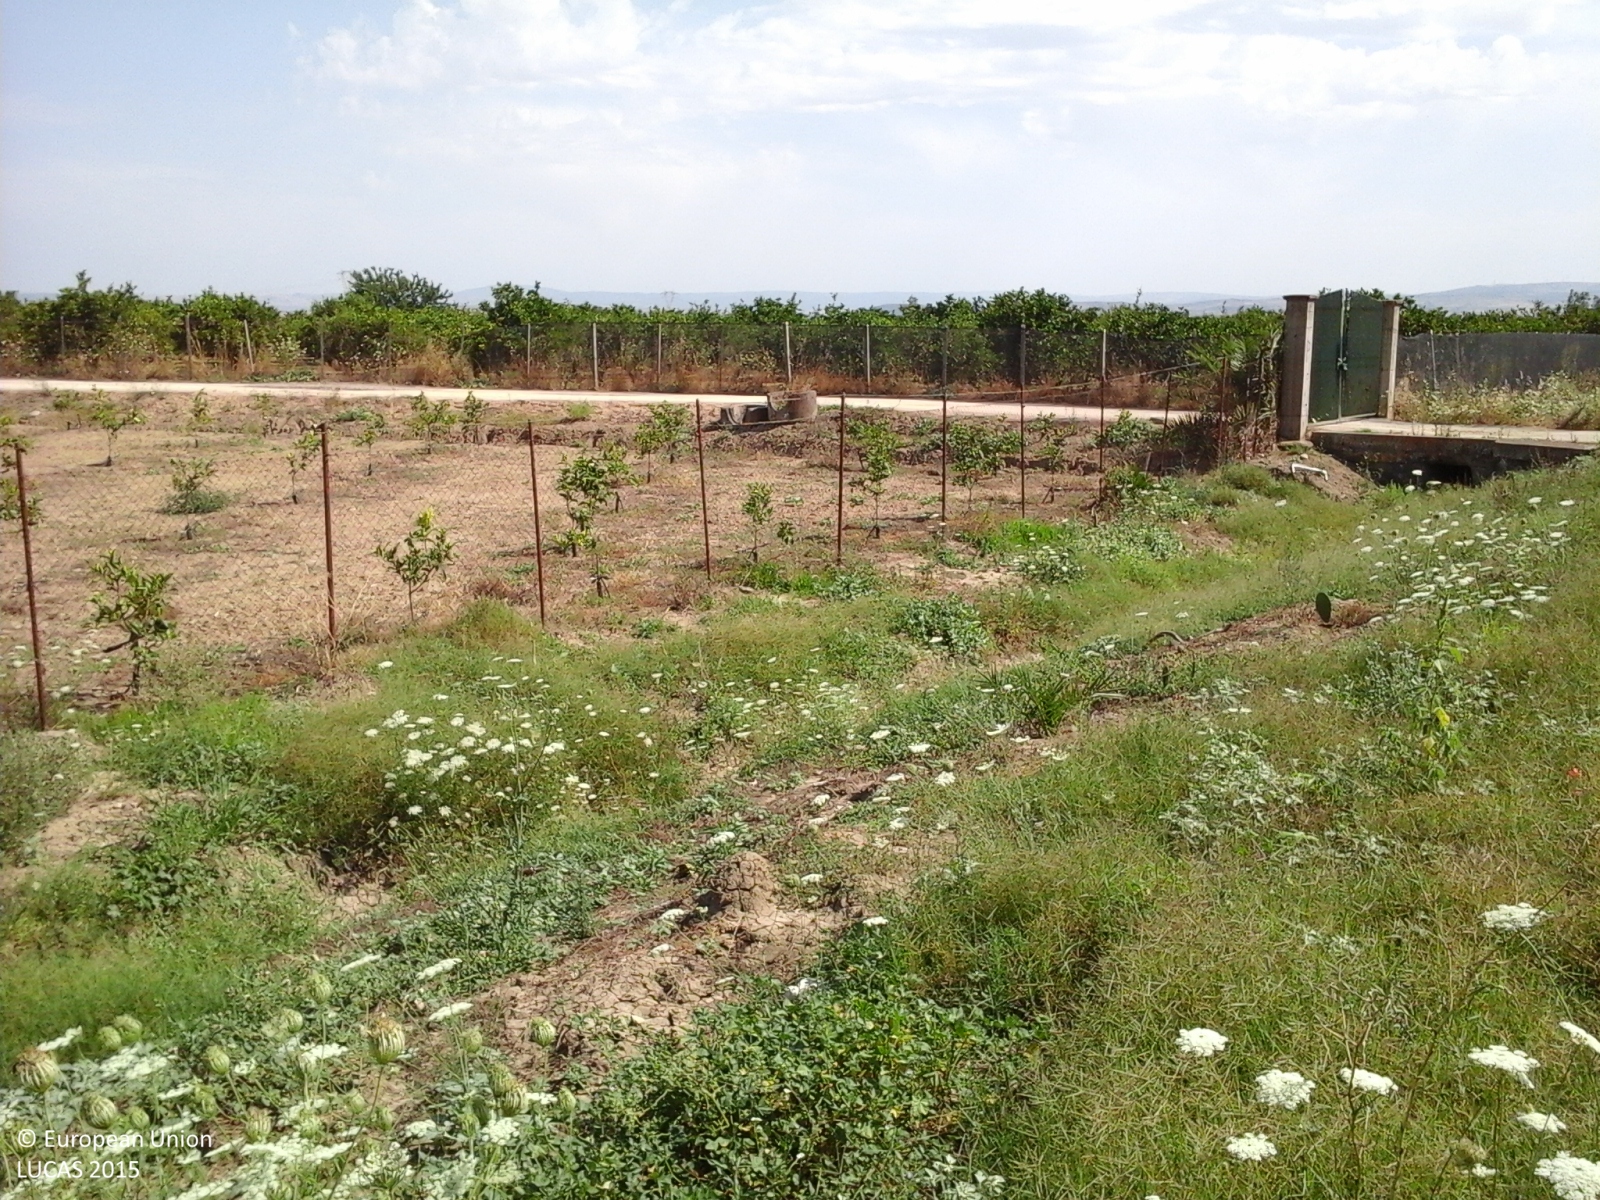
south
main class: Cropland
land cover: Oranges
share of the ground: > 75 %
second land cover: Spontaneously vegetated surfaces
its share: > 75 %
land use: Agriculture (excluding fallow land and kitchen gardens)
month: June
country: IT
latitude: 37.4415
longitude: 14.8585
